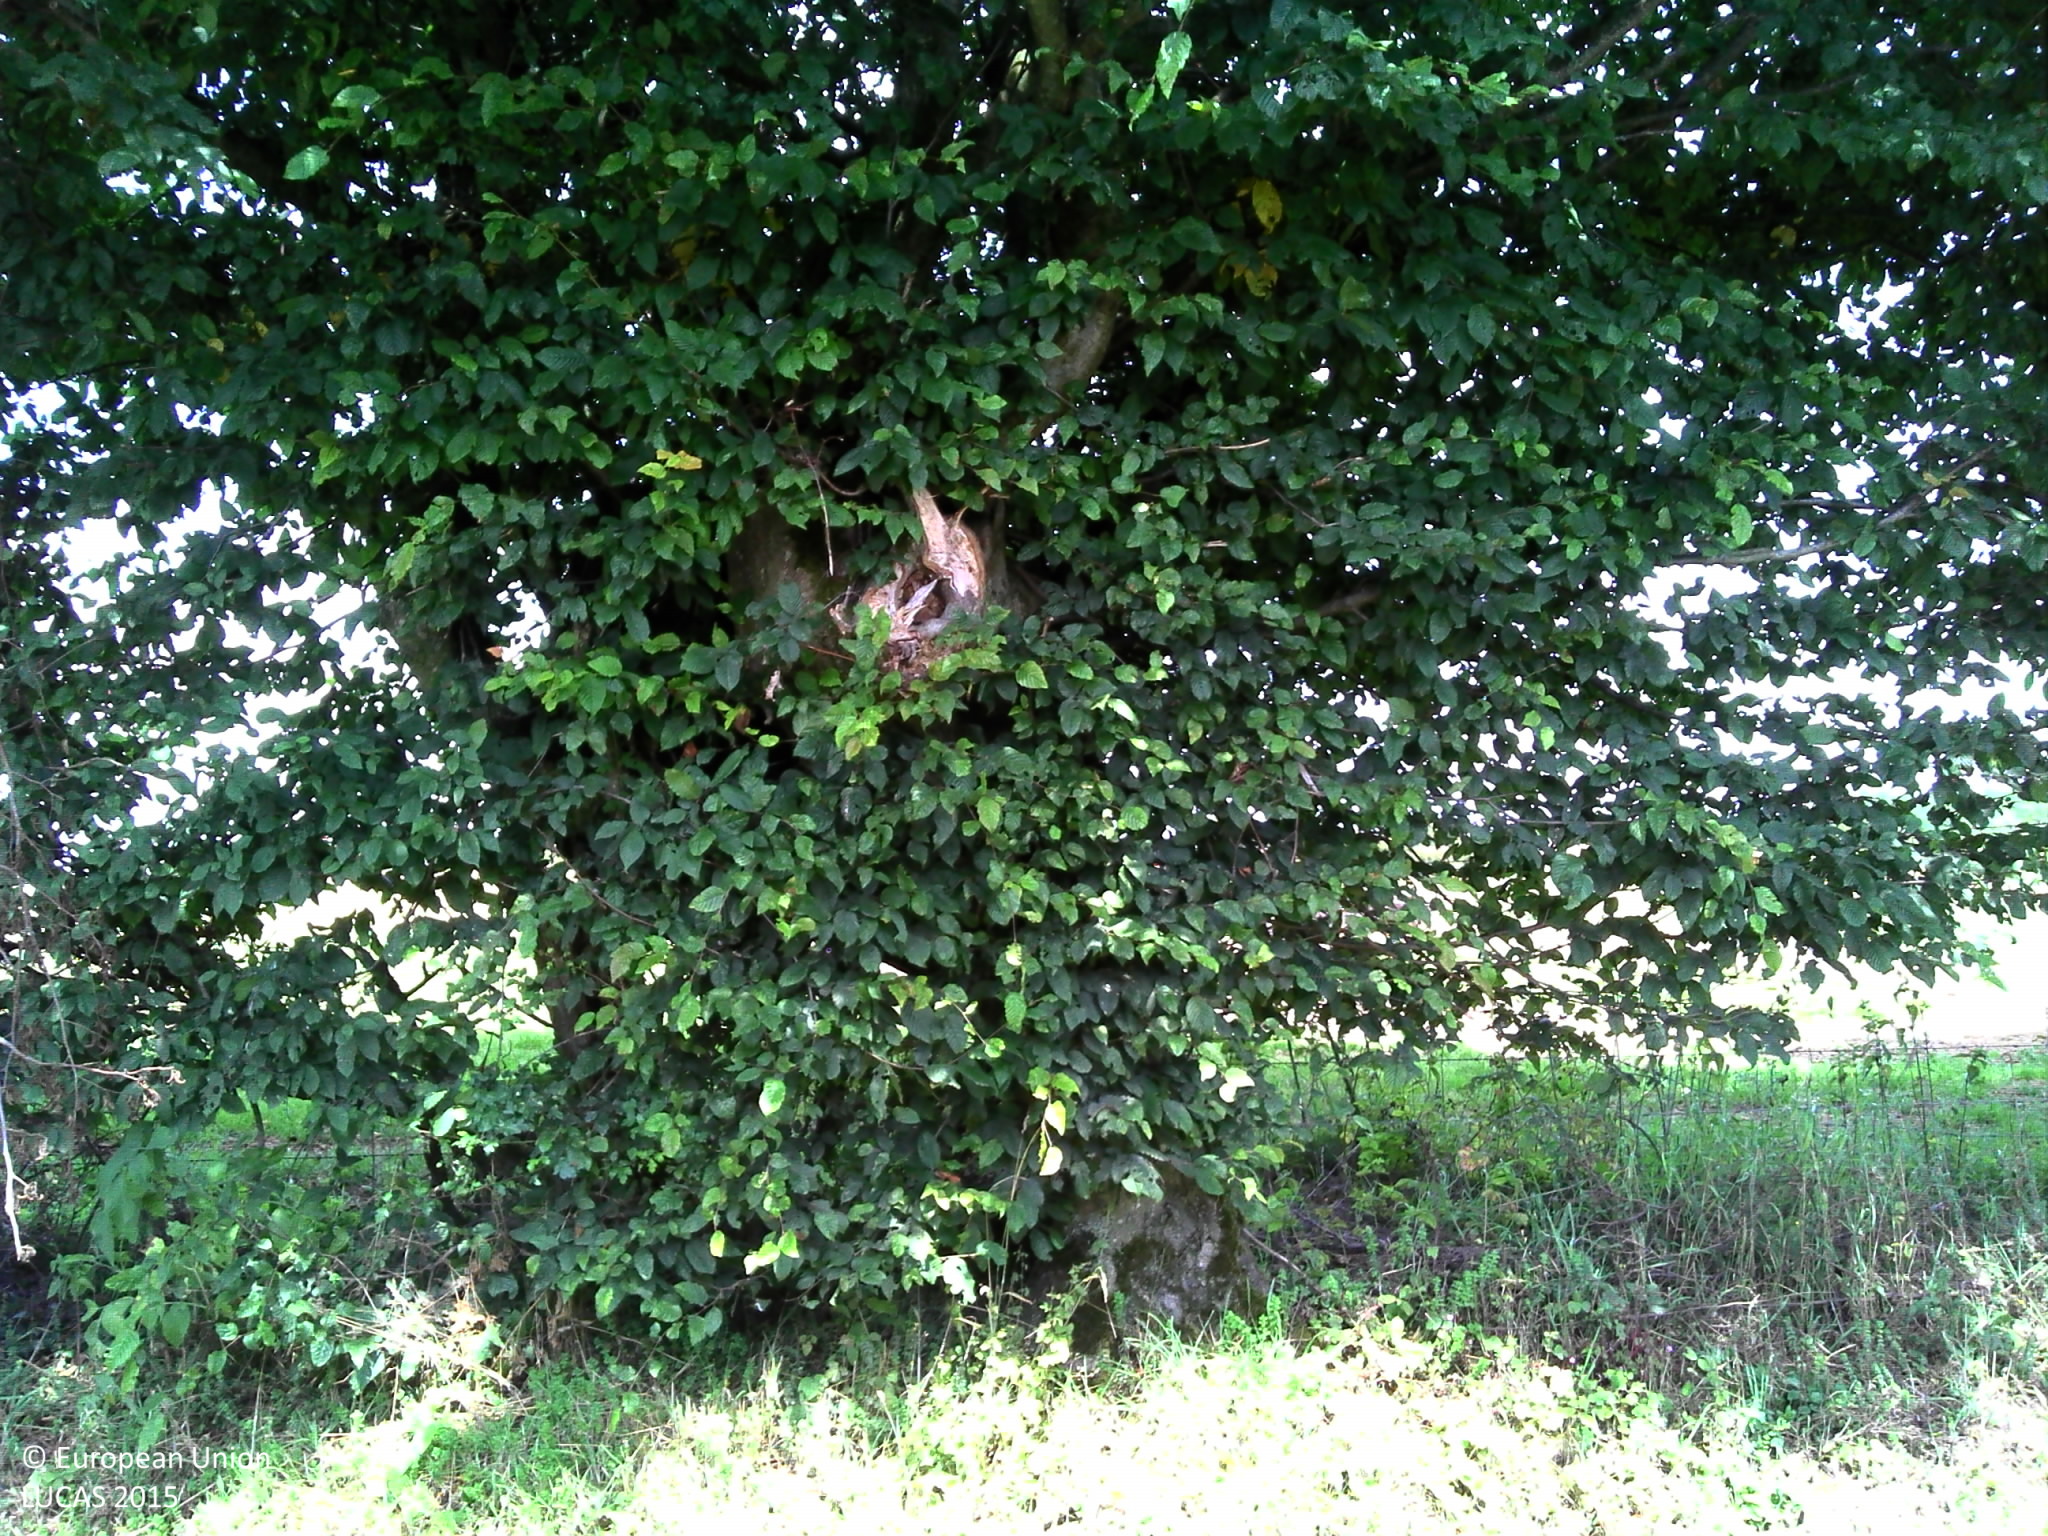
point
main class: Grassland
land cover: Grassland without tree/shrub cover
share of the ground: > 75 %
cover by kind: herbaceous plants 80 %, consolidated bare surface 15 %, lichens and mosses 5 %
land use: Agriculture (excluding fallow land and kitchen gardens)
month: August
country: FR
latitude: 50.0338
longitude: 4.1452
